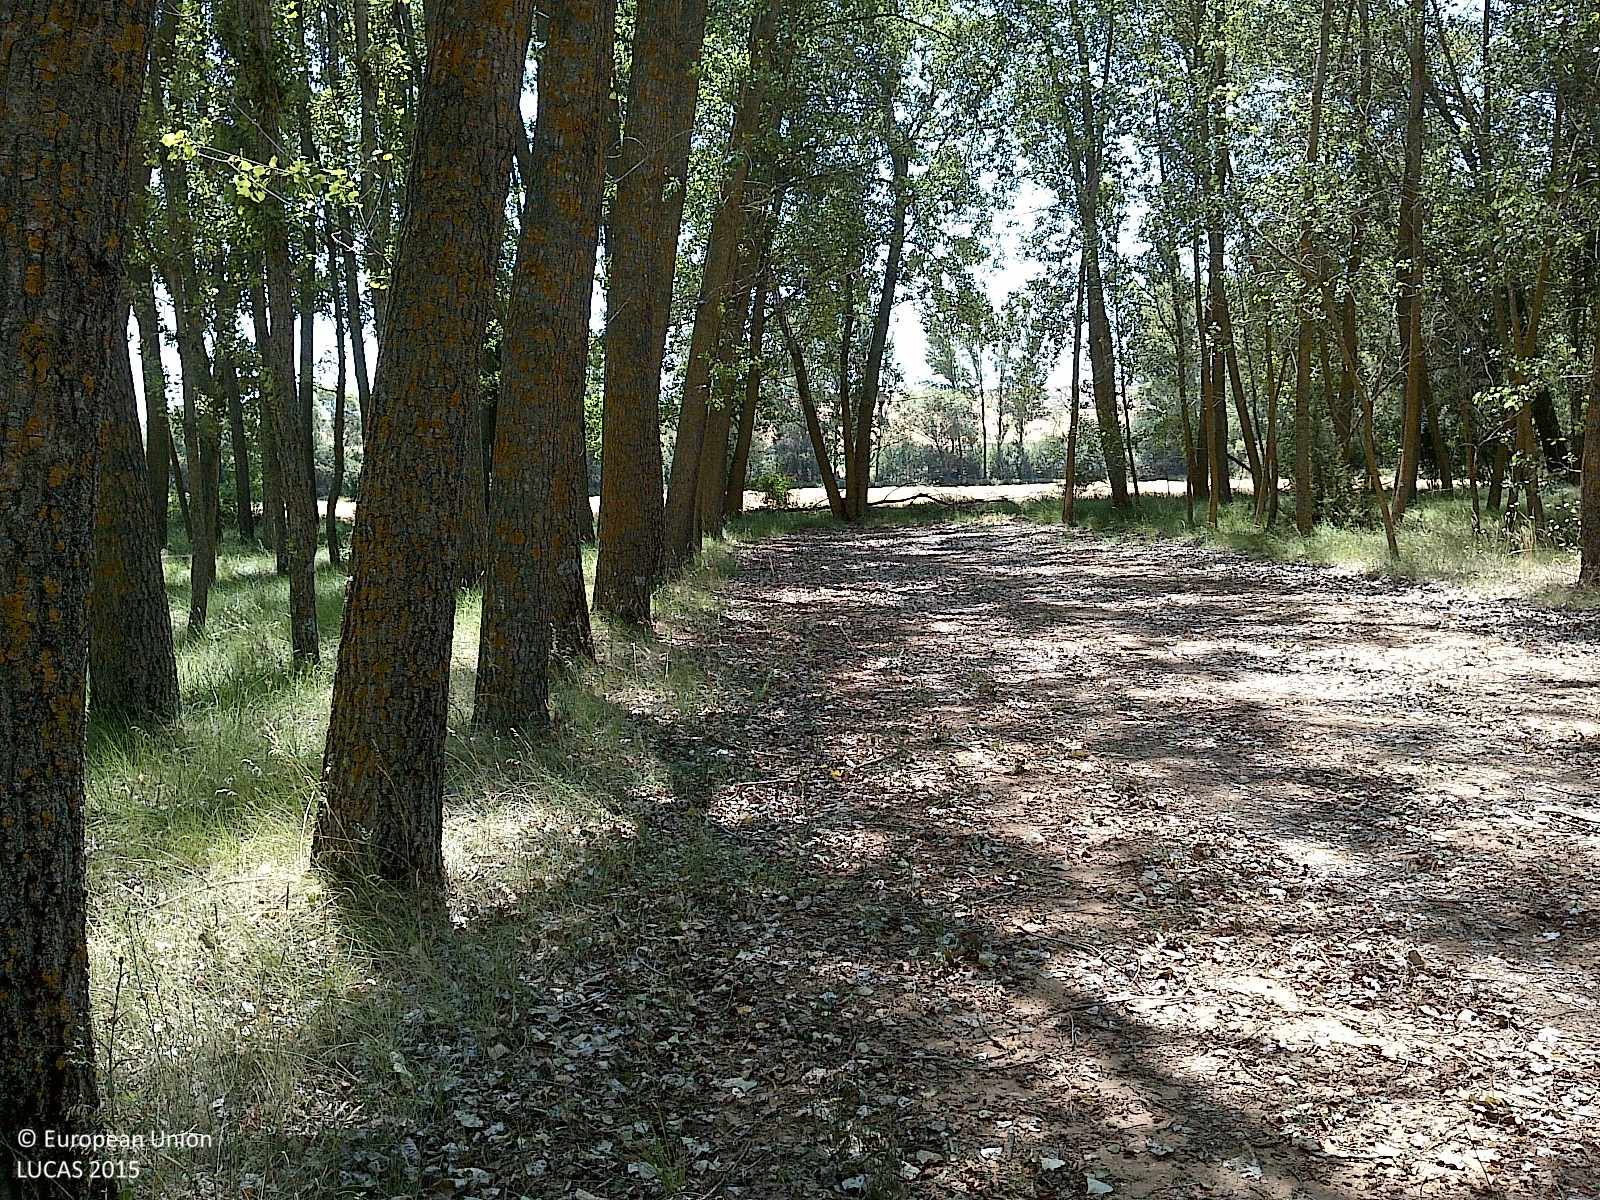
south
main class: Woodland
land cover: Broadleaved woodland
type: exotic forest
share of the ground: > 75 %
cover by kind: broadleaved forest trees 85 %, unconsolidated bare surface 10 %, herbaceous plants 5 %
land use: Forestry
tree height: > 5 m
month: July
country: ES
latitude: 41.7620
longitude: -3.2424
